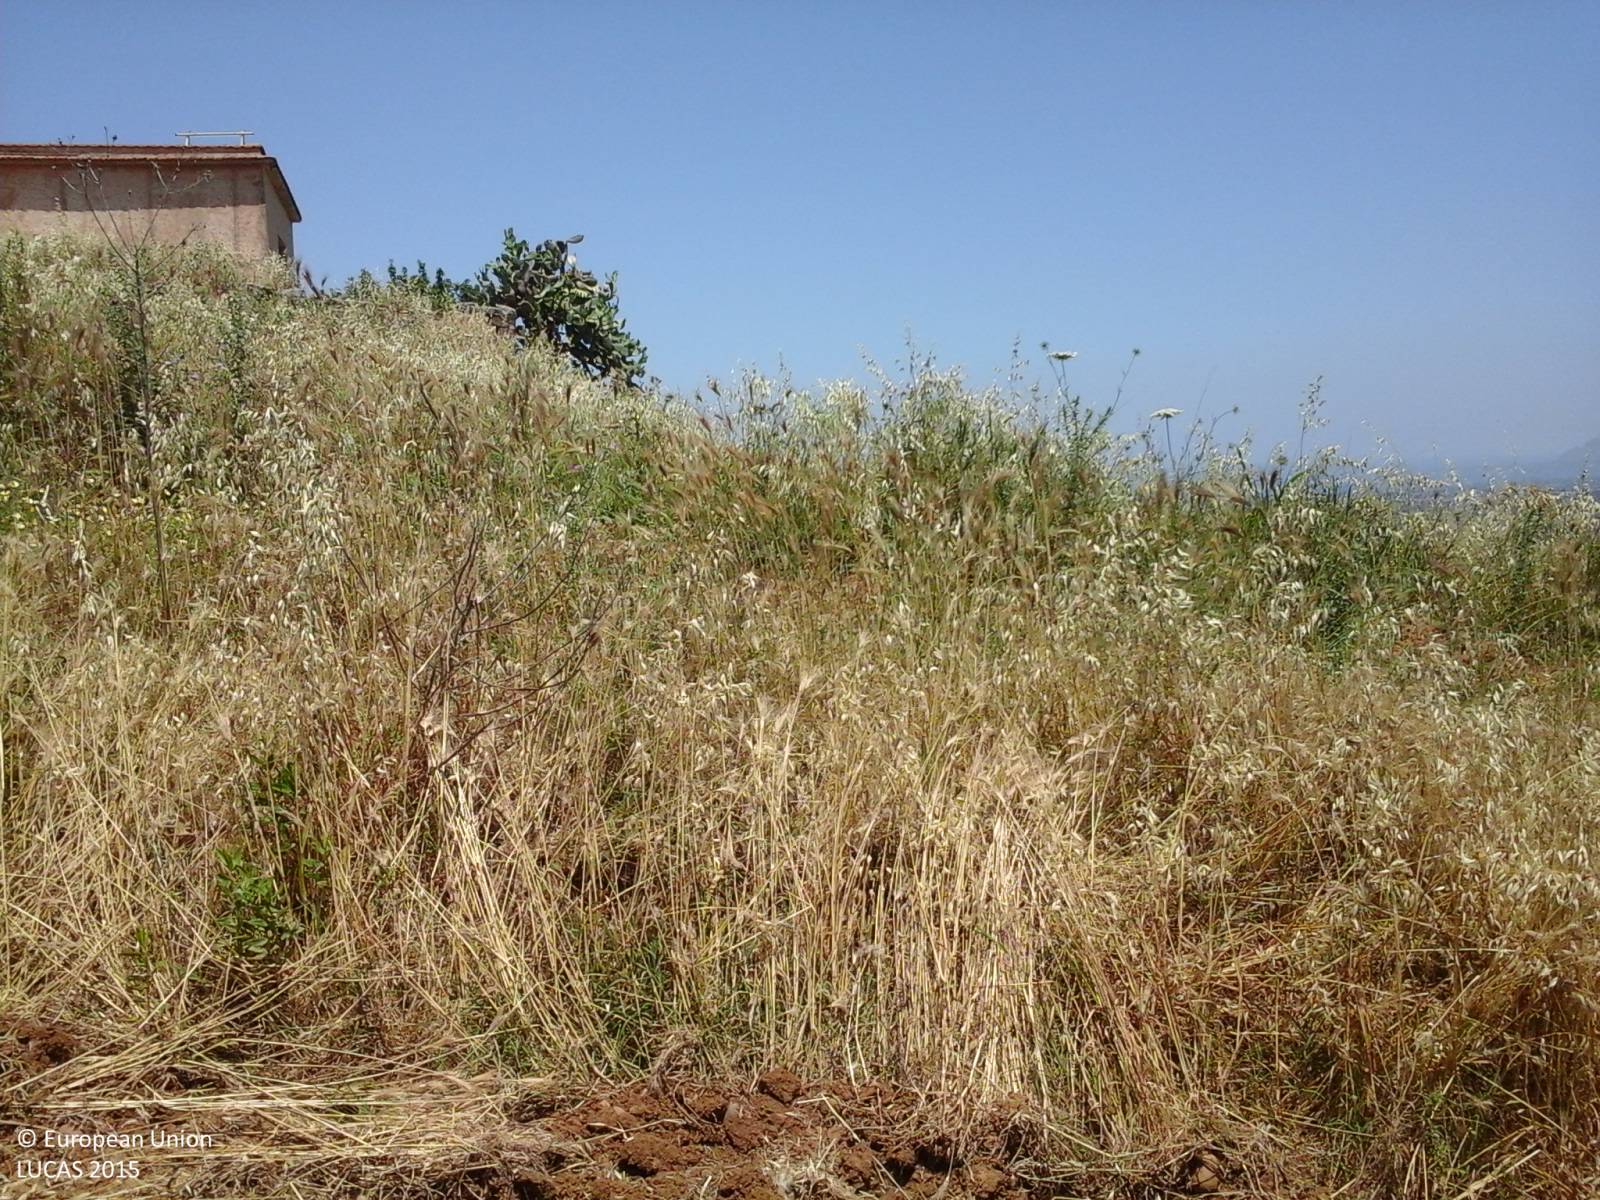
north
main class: Cropland
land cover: Vineyards
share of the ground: 50 - 75 %
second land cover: Other bare soil
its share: > 75 %
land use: Agriculture (excluding fallow land and kitchen gardens)
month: June
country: IT
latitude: 37.9547
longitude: 12.9943
